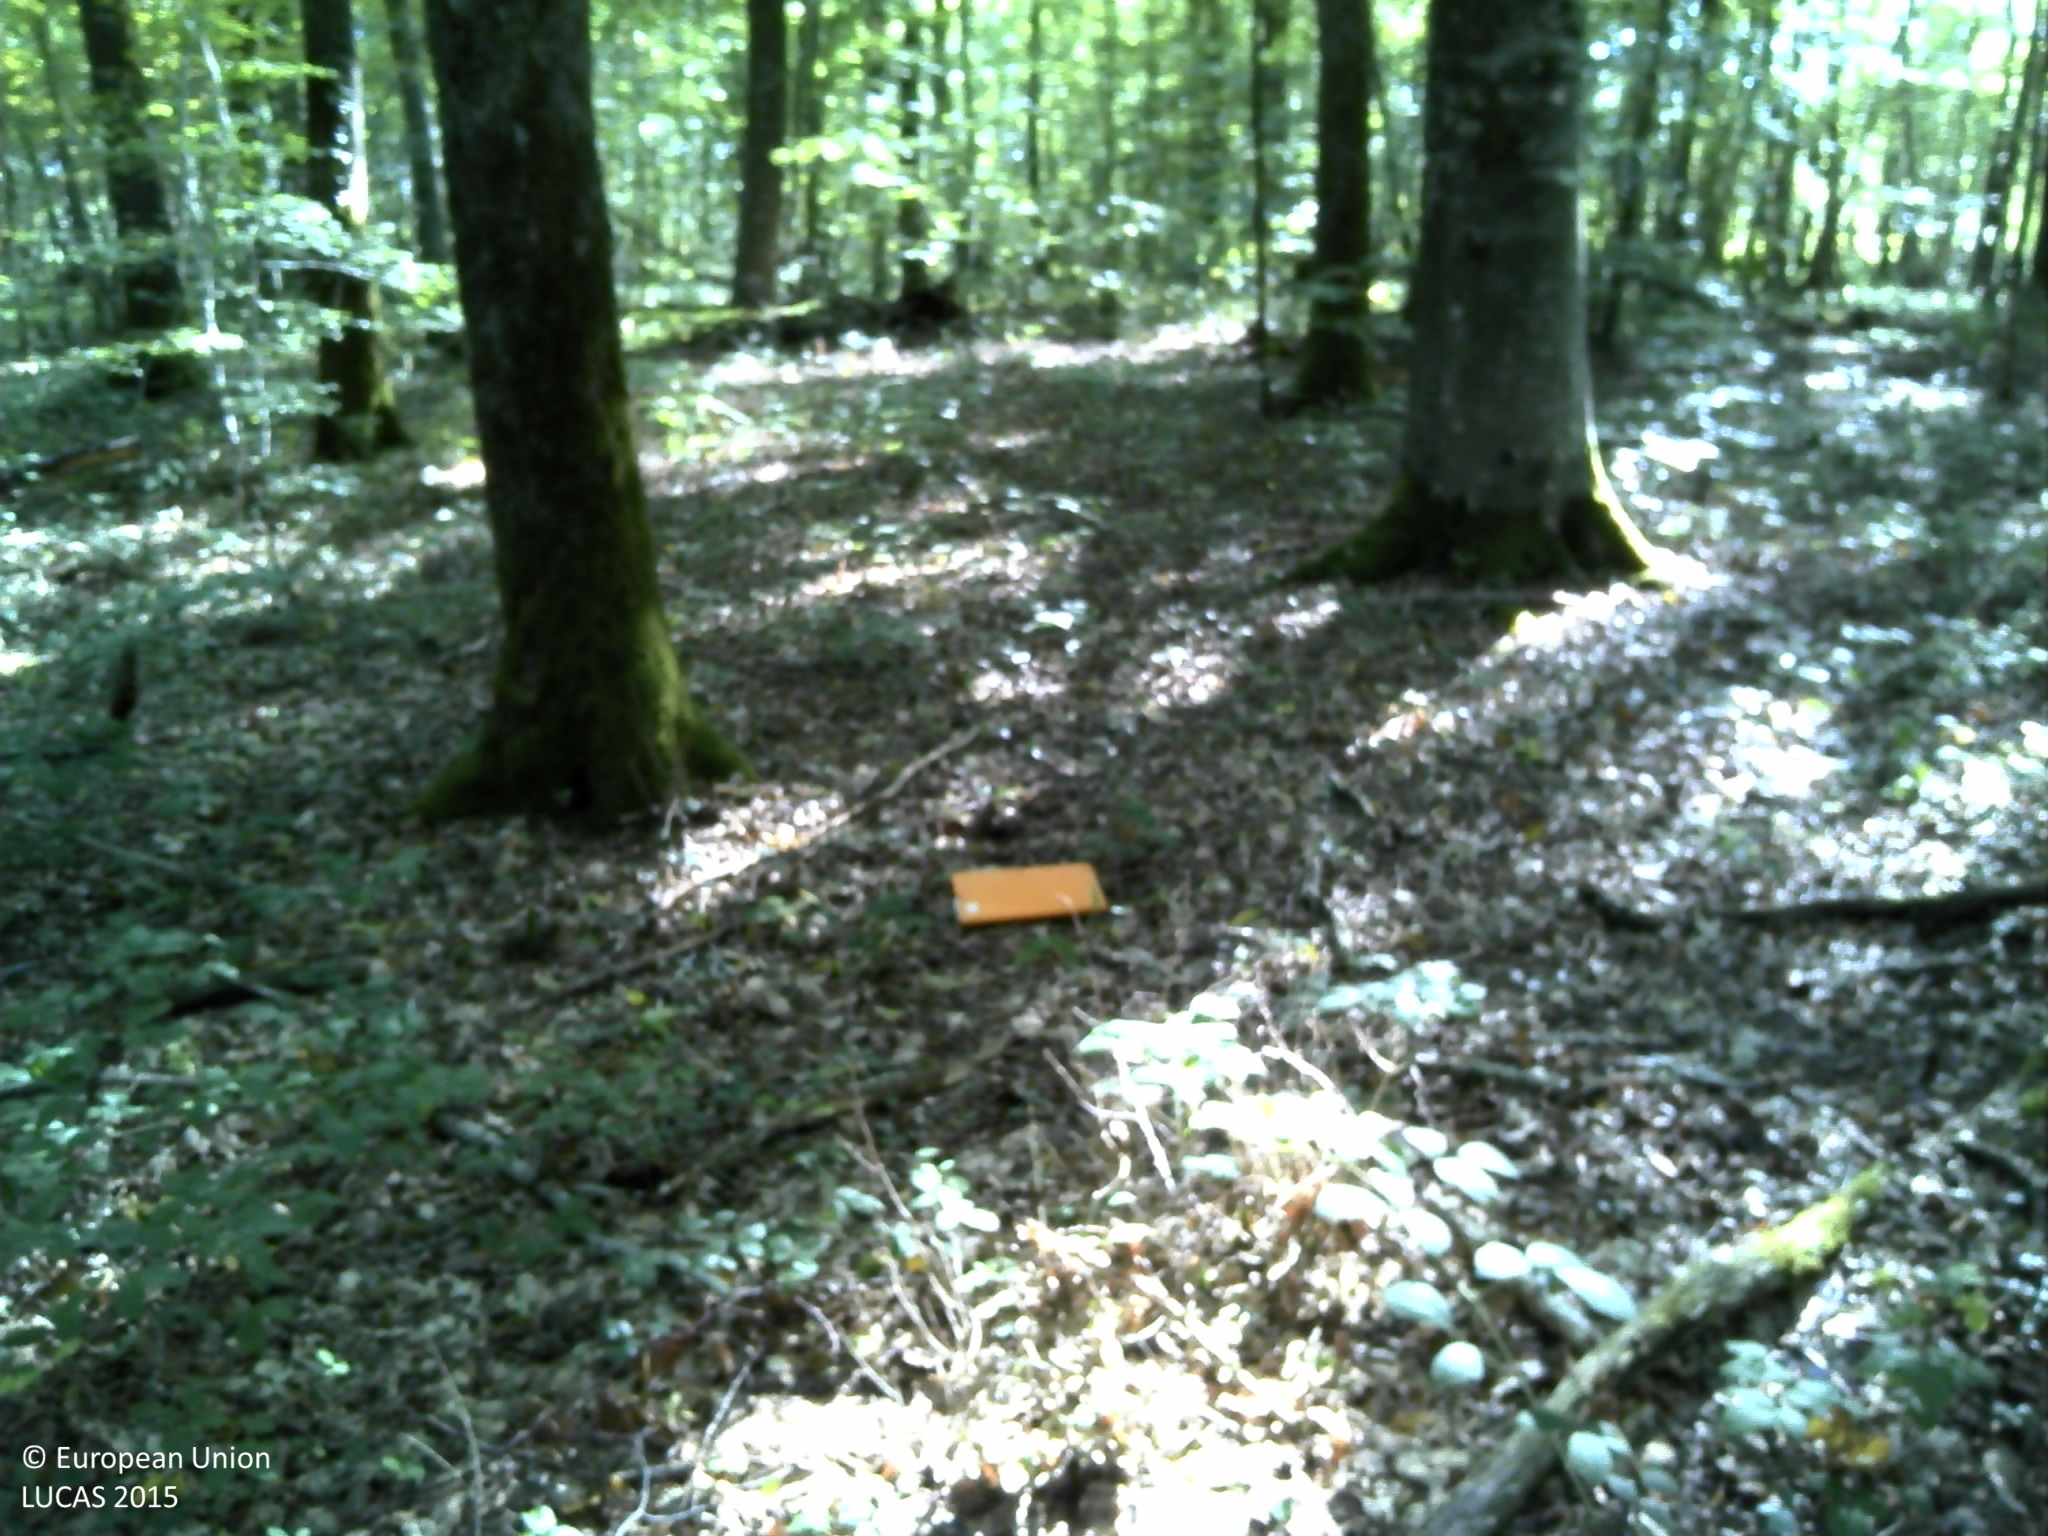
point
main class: Woodland
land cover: Broadleaved woodland
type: mesophytic deciduous forest
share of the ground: > 75 %
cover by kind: broadleaved forest trees 85 %, herbaceous plants 10 %, lichens and mosses 5 %
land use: Forestry
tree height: > 5 m
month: September
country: FR
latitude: 46.8736
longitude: 4.4242
